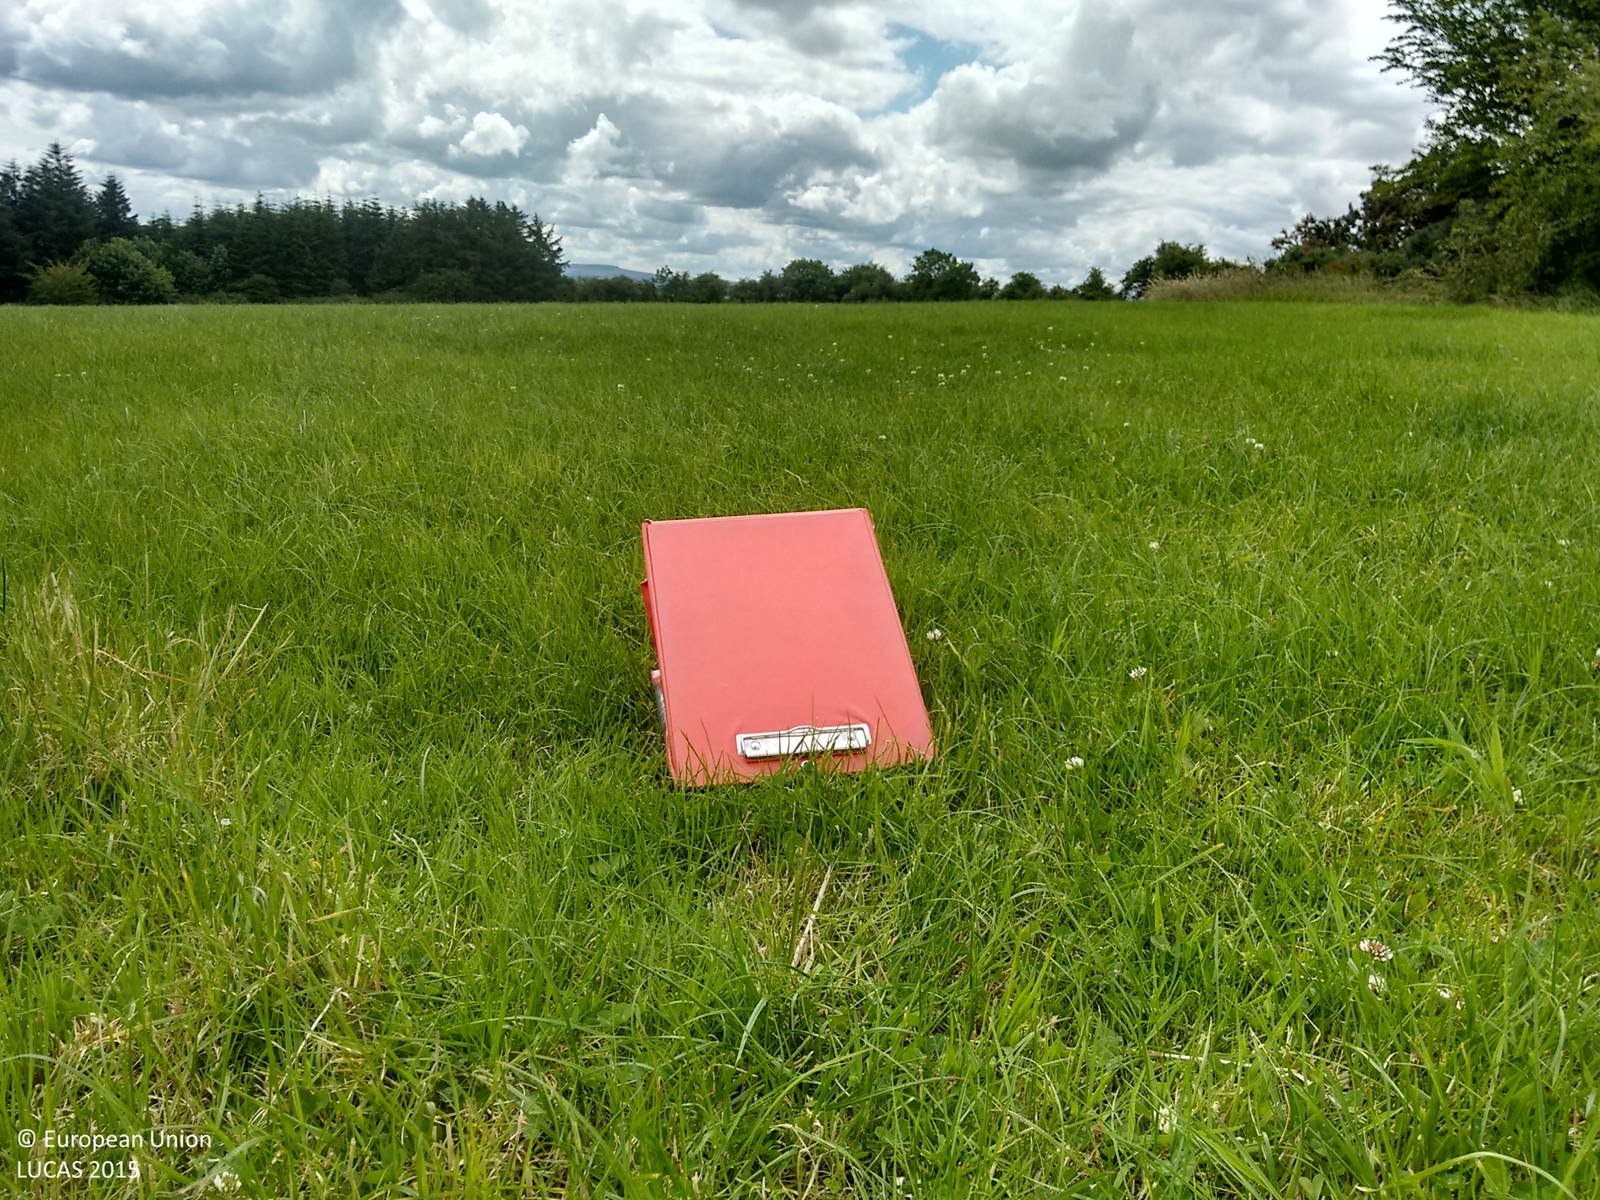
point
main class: Grassland
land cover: Grassland without tree/shrub cover
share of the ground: > 75 %
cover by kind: herbaceous plants 95 %, shrubs 5 %
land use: Agriculture (excluding fallow land and kitchen gardens)
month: July
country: IE
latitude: 52.2987
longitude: -8.9057
